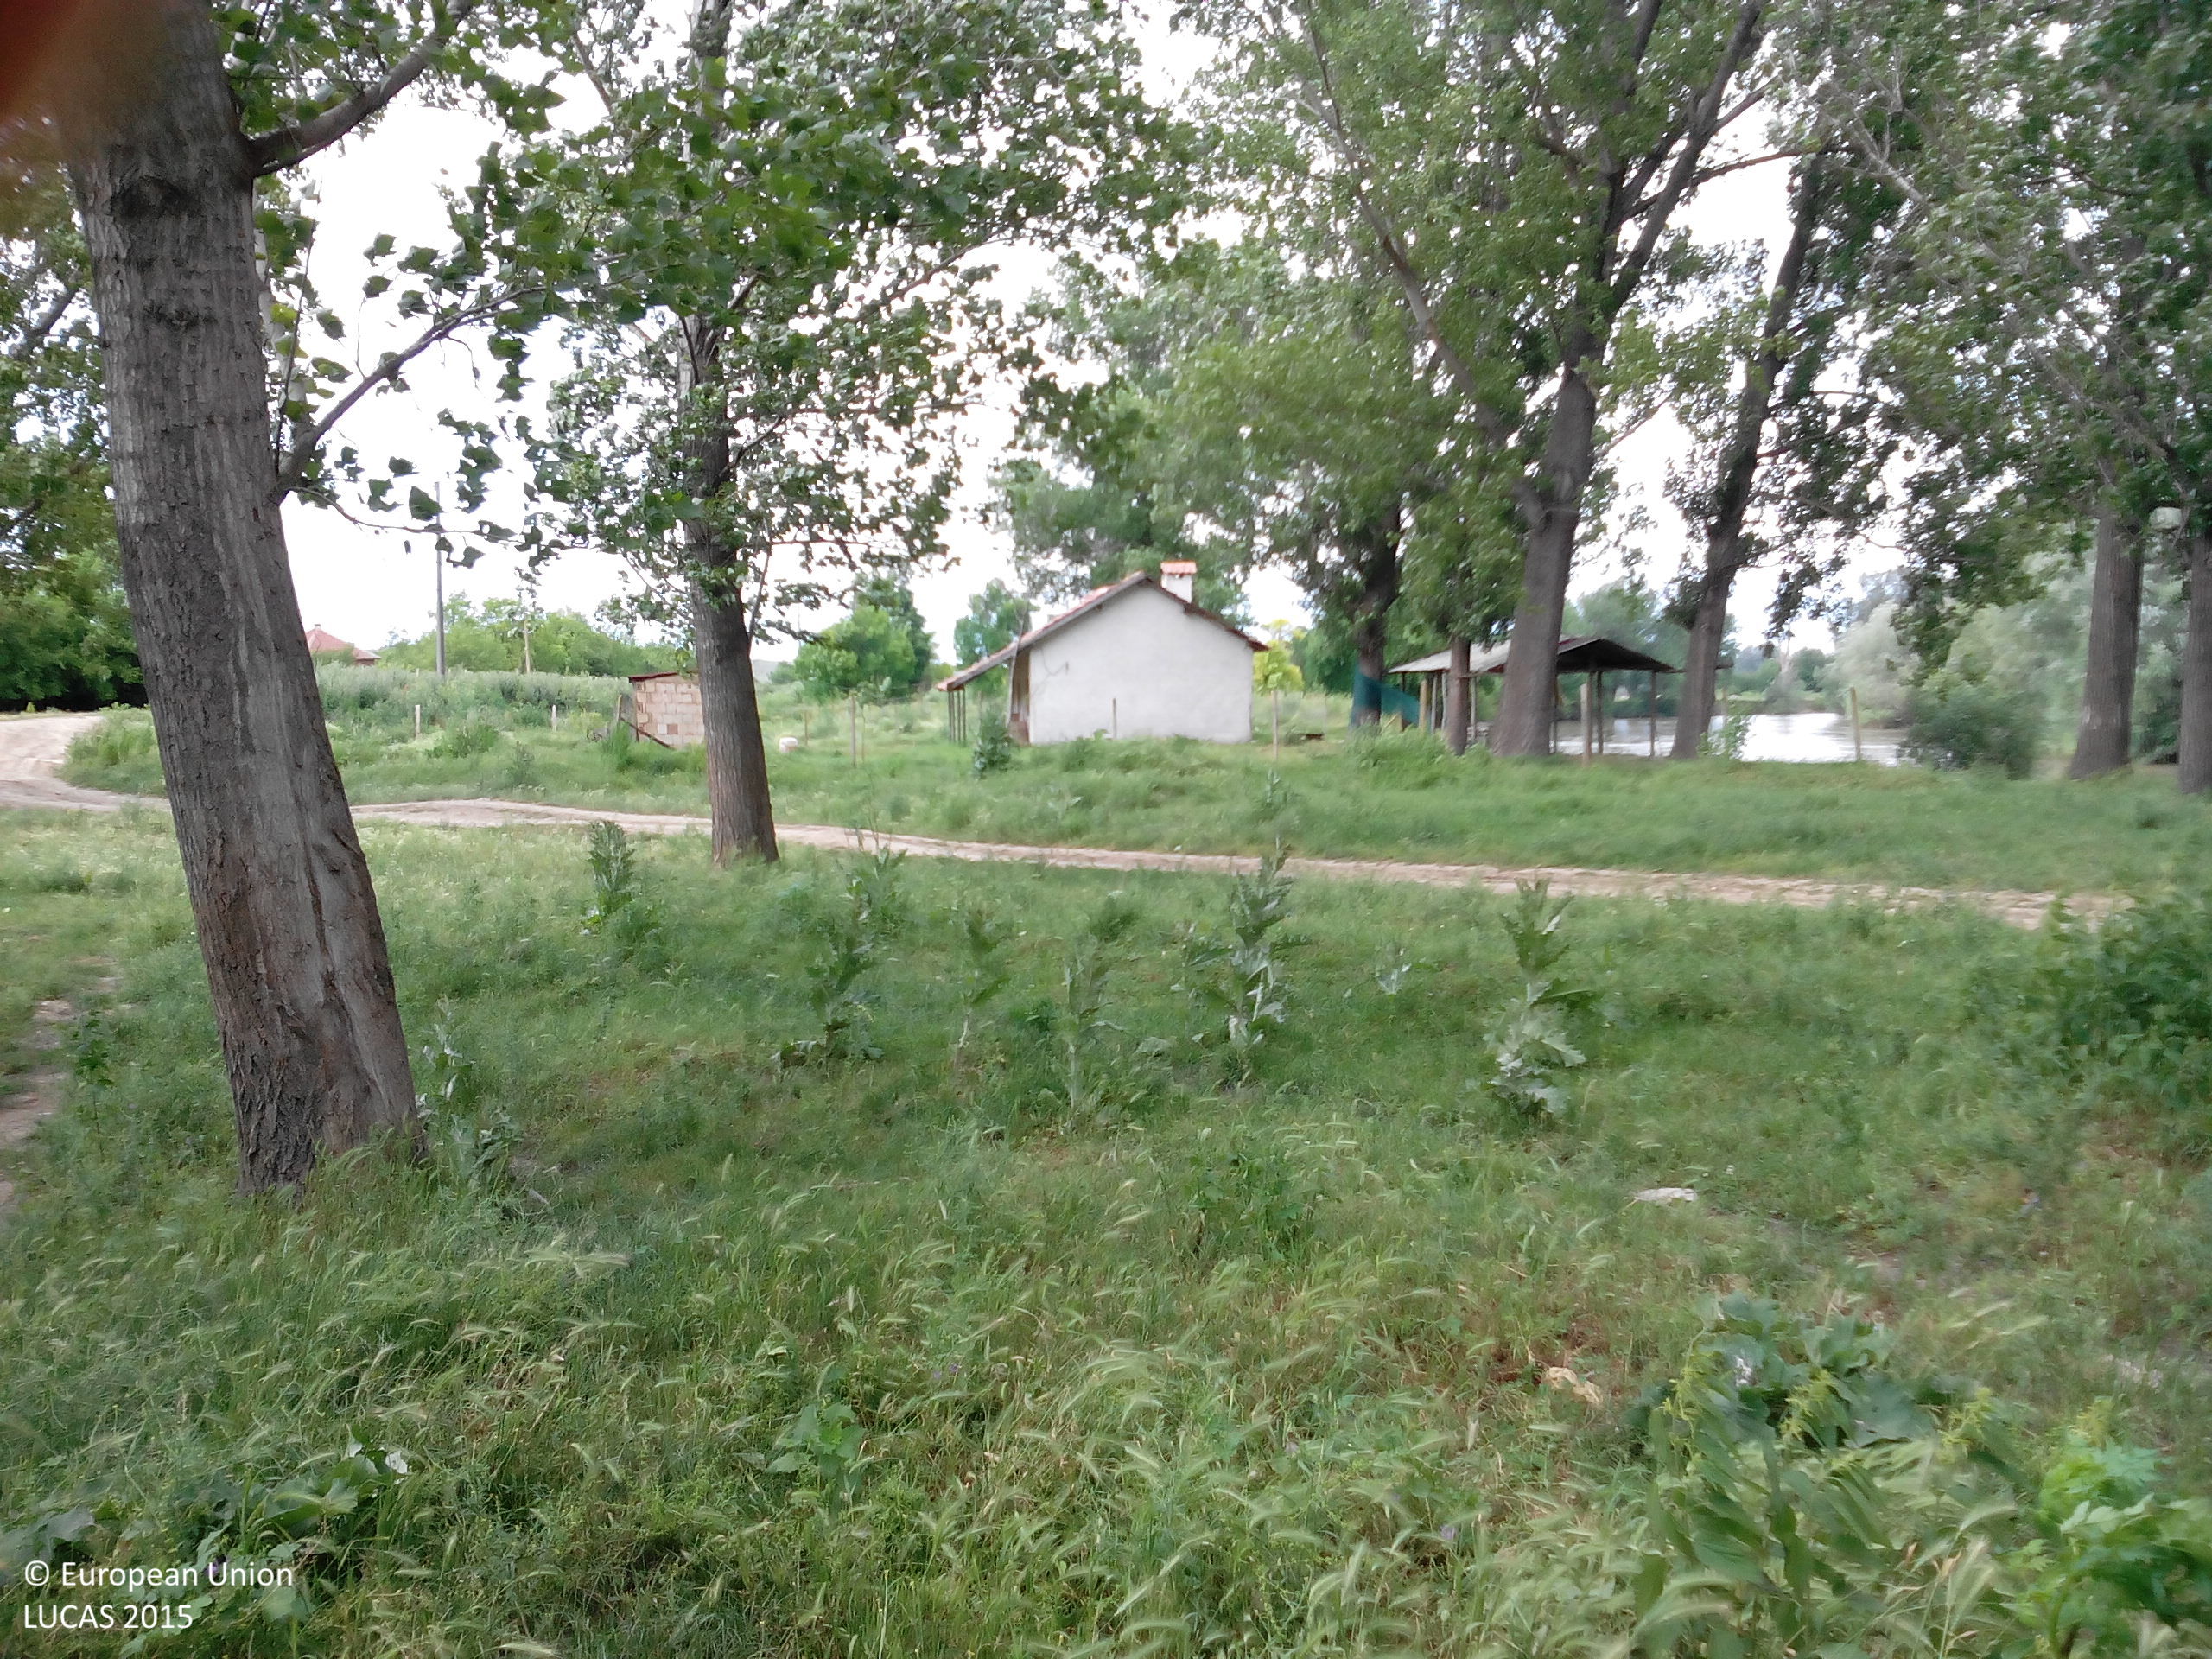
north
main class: Woodland
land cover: Broadleaved woodland
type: mesophytic deciduous forest
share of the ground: 50 - 75 %
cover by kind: broadleaved forest trees 70 %, herbaceous plants 30 %
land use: Forestry
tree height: > 5 m
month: May
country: BG
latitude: 43.5117
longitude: 24.2202
